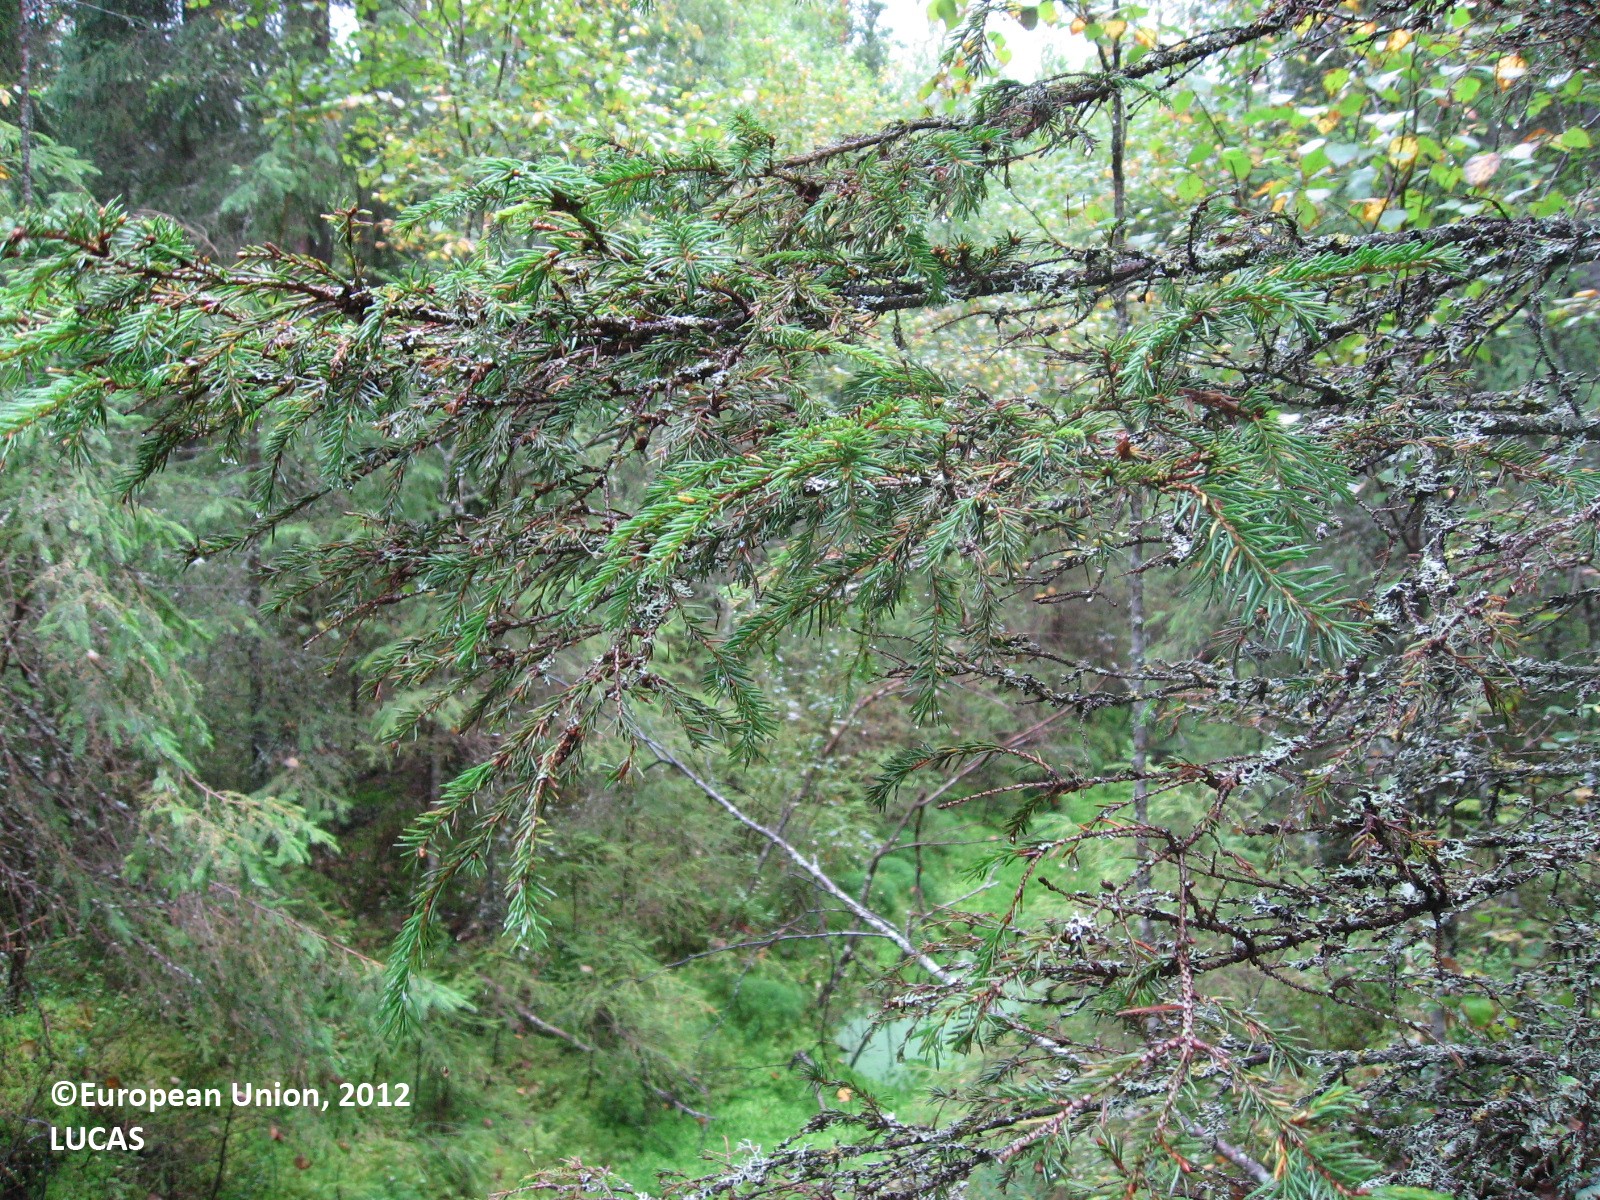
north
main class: Woodland
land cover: Spruce dominated mixed woodland
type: boreal forest
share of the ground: 50 - 75 %
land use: Forestry
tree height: > 5 m
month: August
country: FI
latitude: 61.4901
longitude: 24.9643
